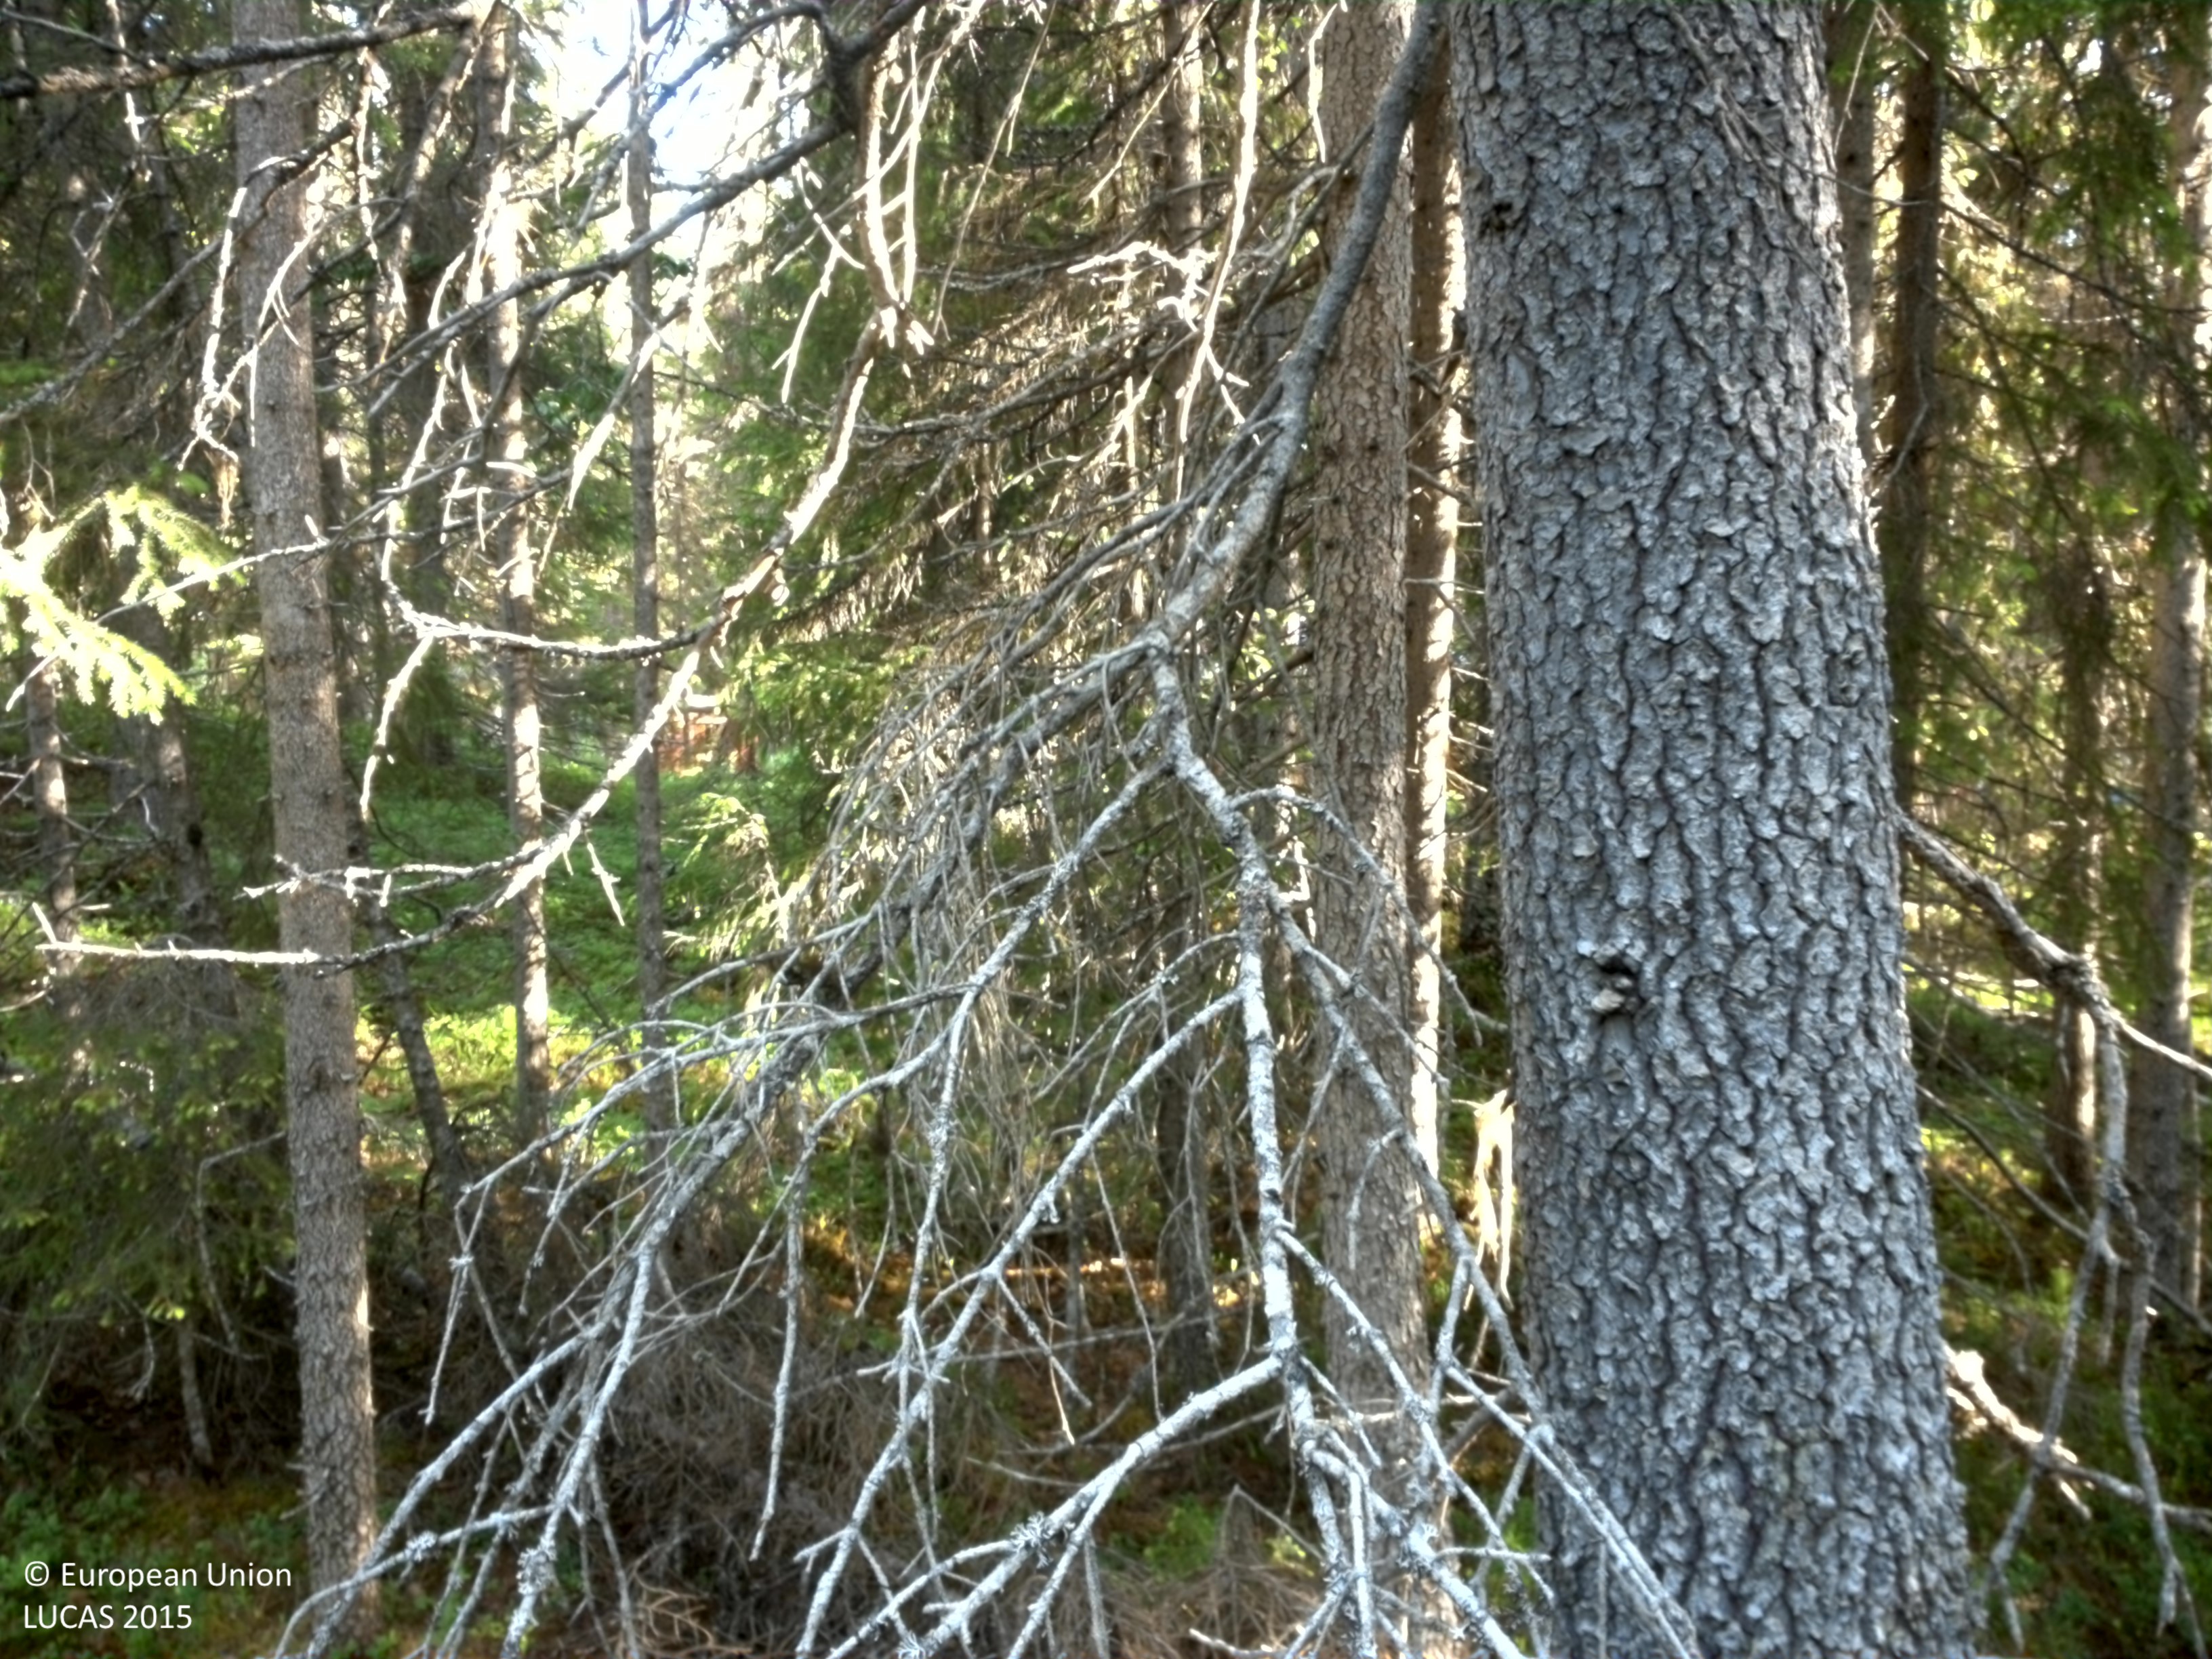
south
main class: Woodland
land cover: Spruce dominated coniferous woodland
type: boreal forest
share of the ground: 25 - 50 %
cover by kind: coniferous forest trees 40 %, shrubs 30 %, lichens and mosses 15 %, herbaceous plants 10 %, broadleaved forest trees 5 %
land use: Forestry
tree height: > 5 m
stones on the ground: < 10 %
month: July
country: SE
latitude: 65.5559
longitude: 15.4008
